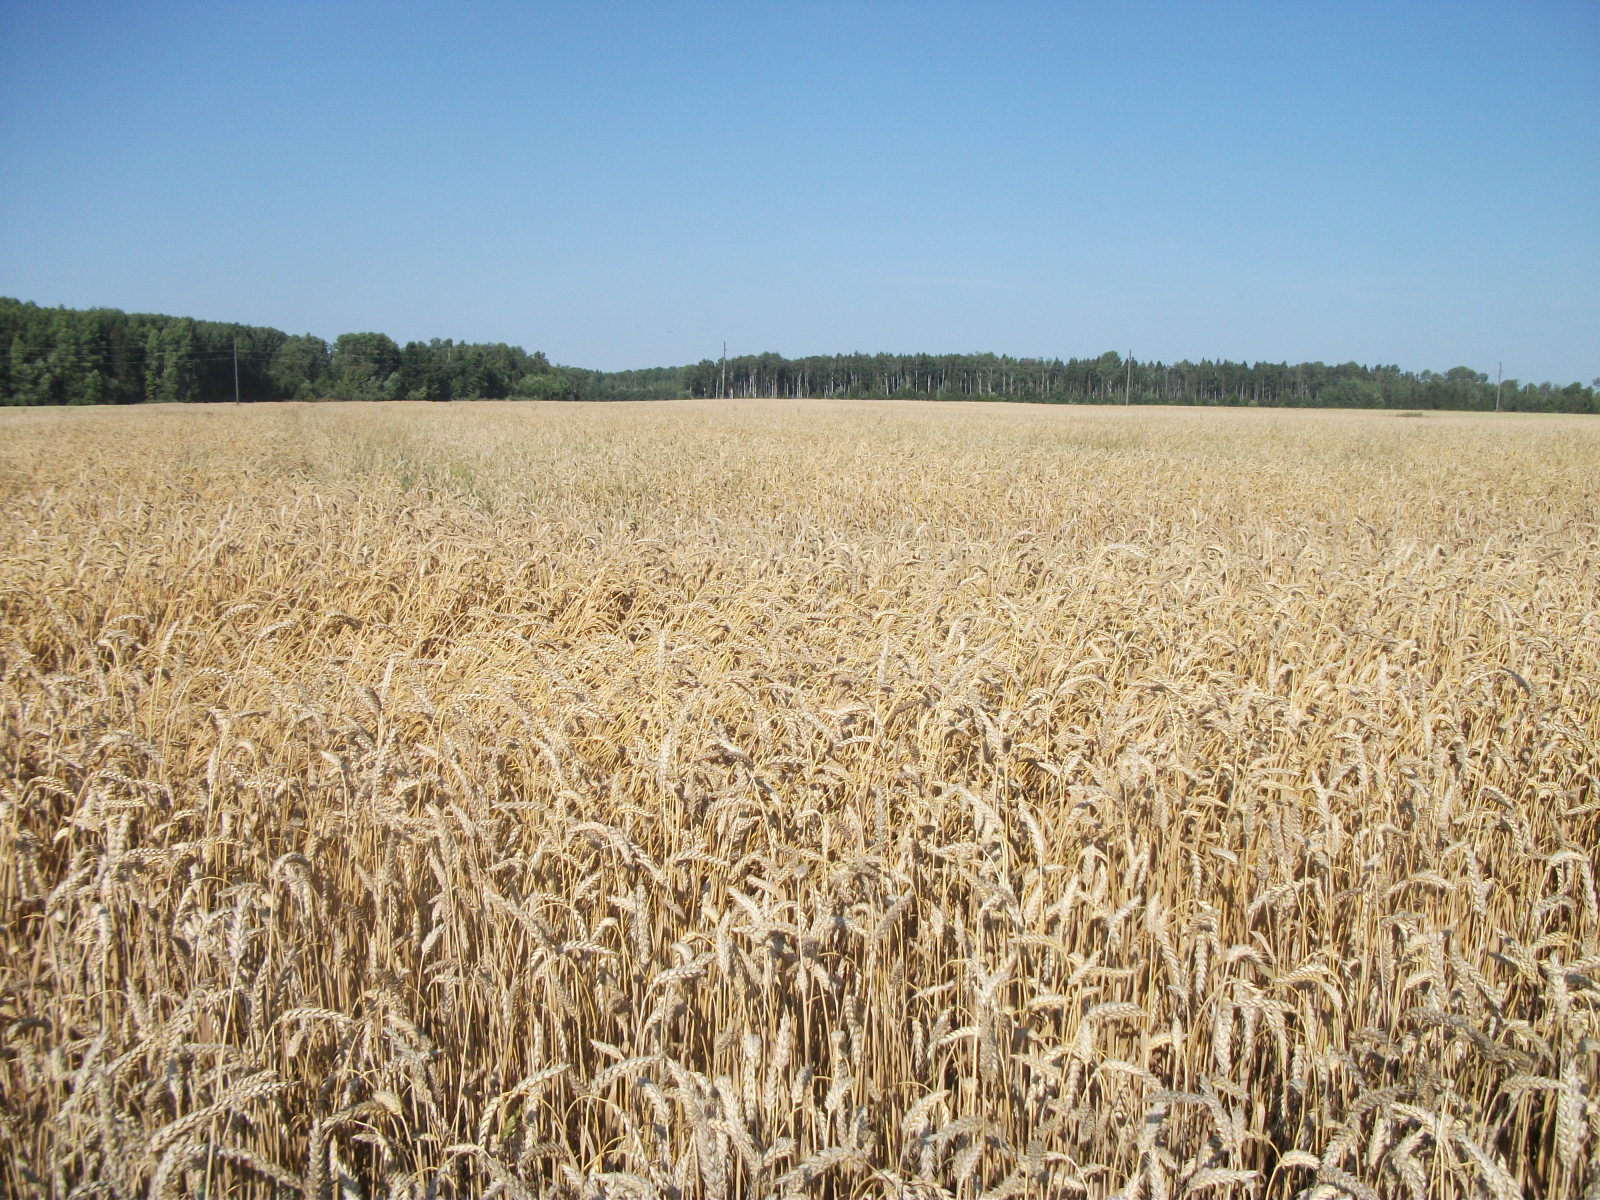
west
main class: Cropland
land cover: Common wheat
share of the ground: > 75 %
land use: Agriculture (excluding fallow land and kitchen gardens)
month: August
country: LV
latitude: 56.7323
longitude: 26.6098
